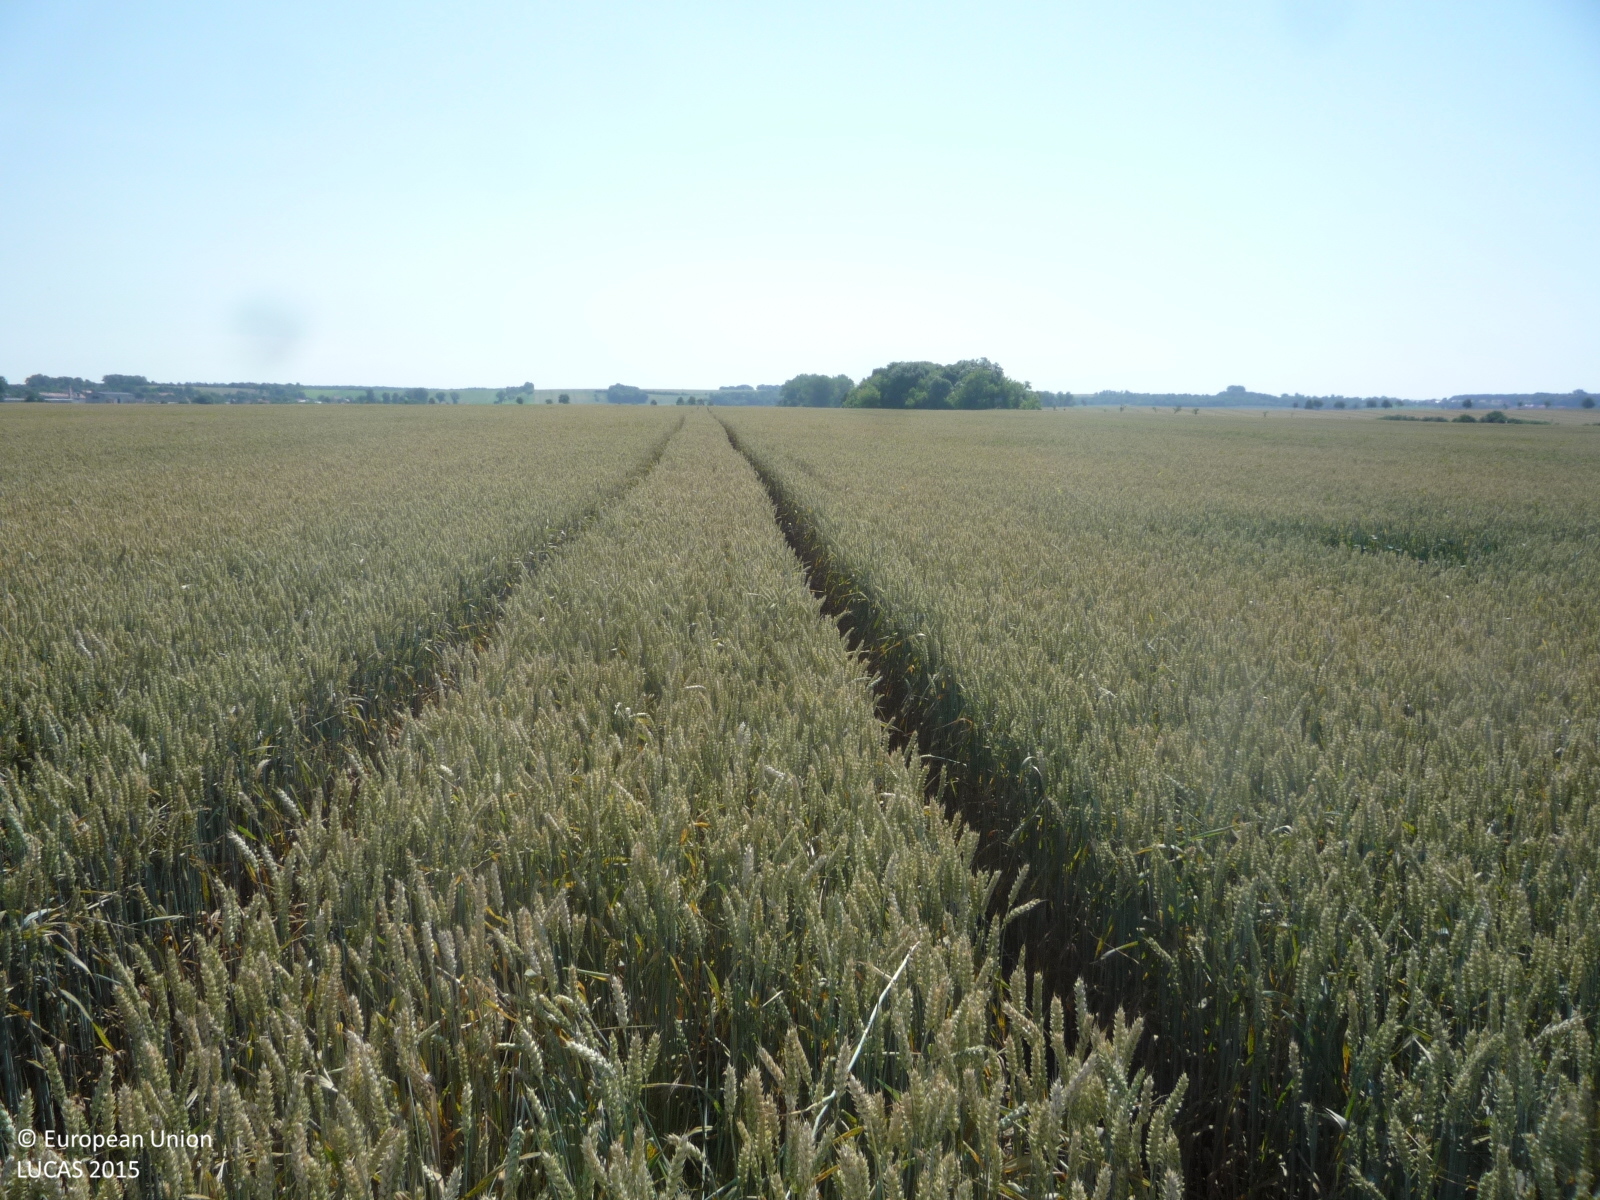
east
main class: Cropland
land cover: Common wheat
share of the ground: > 75 %
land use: Agriculture (excluding fallow land and kitchen gardens)
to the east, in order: Common wheat
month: July
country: CZ
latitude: 50.2097
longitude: 15.2019
